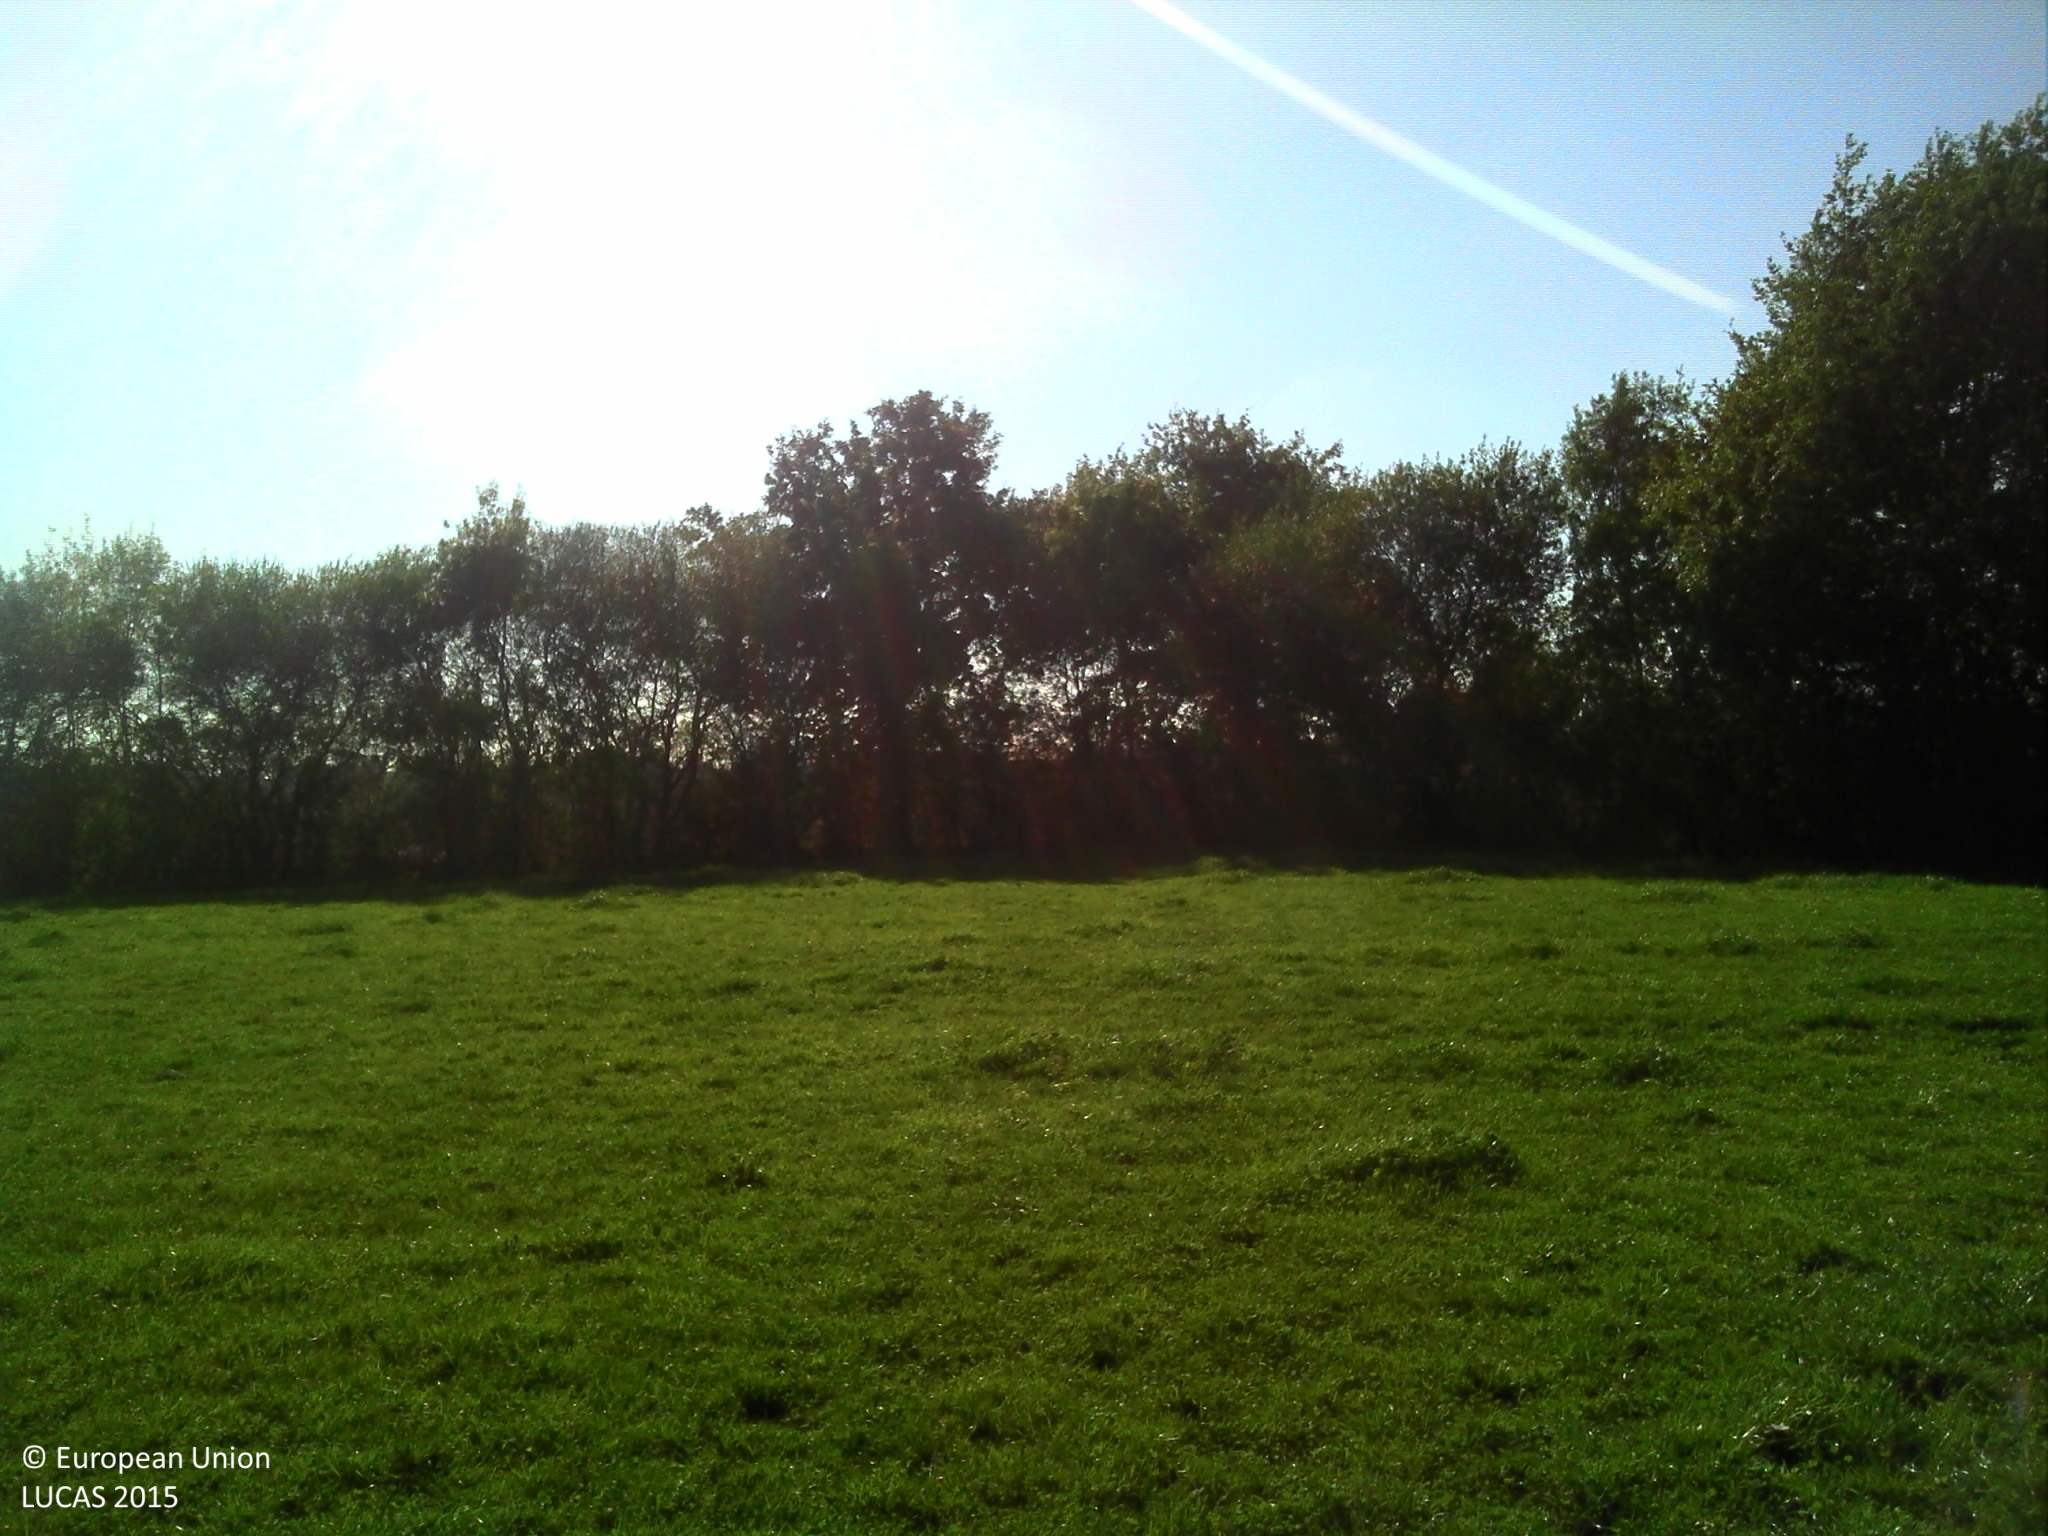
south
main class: Grassland
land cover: Grassland without tree/shrub cover
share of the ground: > 75 %
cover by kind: herbaceous plants 100 %
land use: Agriculture (excluding fallow land and kitchen gardens)
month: October
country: FR
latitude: 47.1177
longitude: -0.9074
